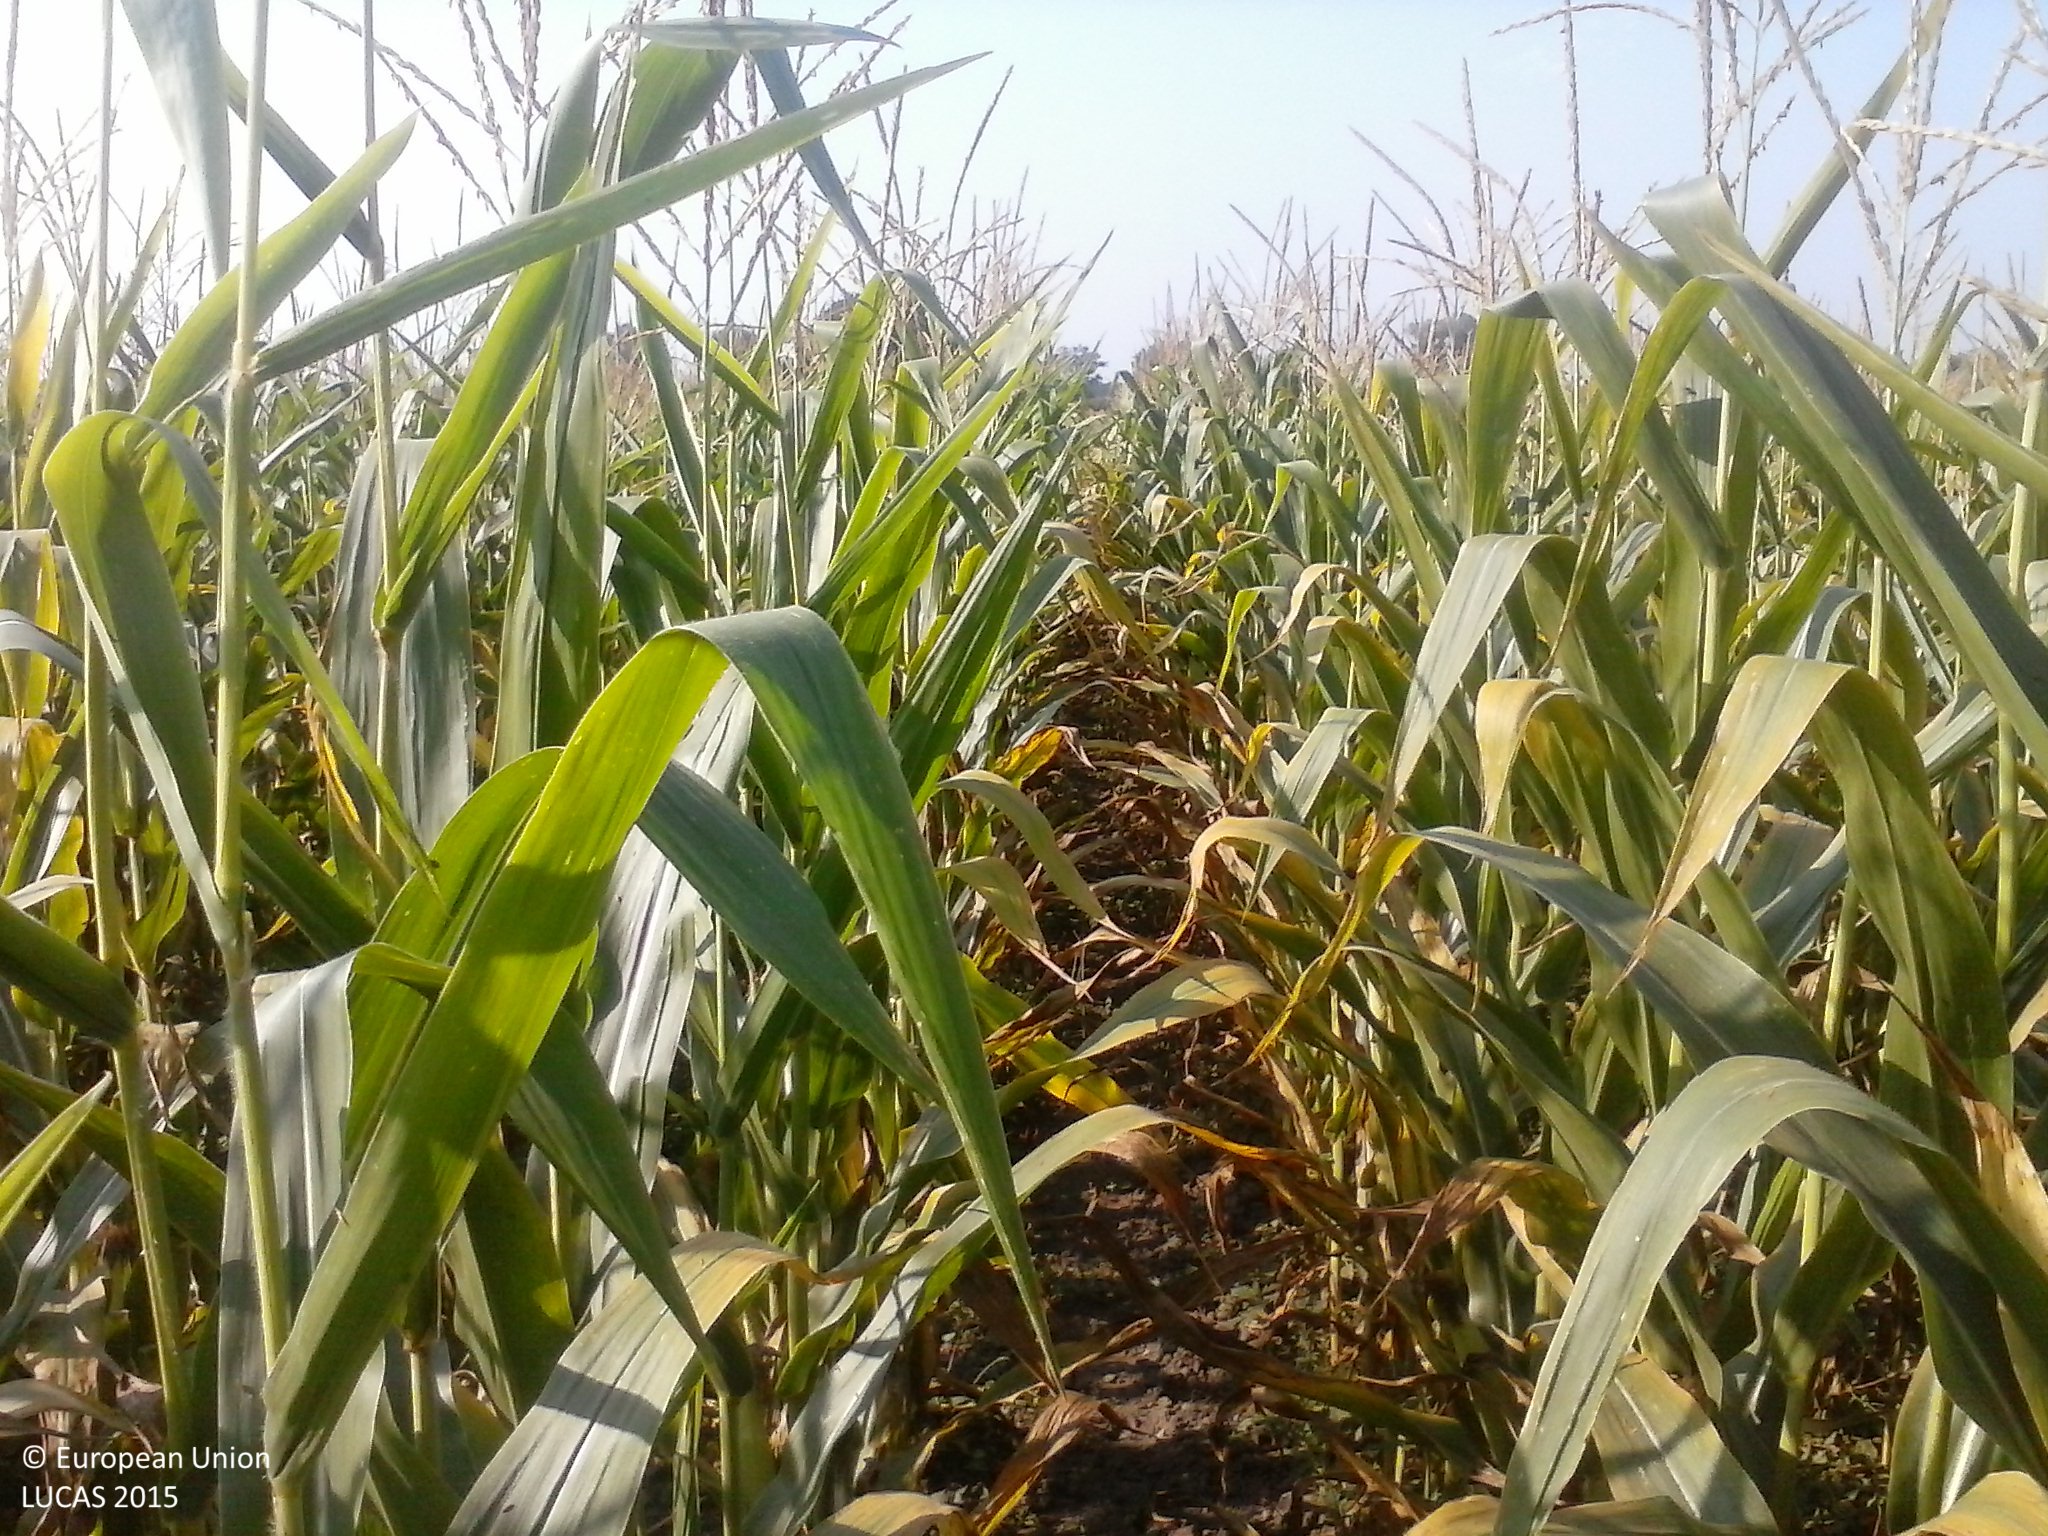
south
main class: Cropland
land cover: Maize
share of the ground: > 75 %
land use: Agriculture (excluding fallow land and kitchen gardens)
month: August
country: HU
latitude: 45.8955
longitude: 17.9052
